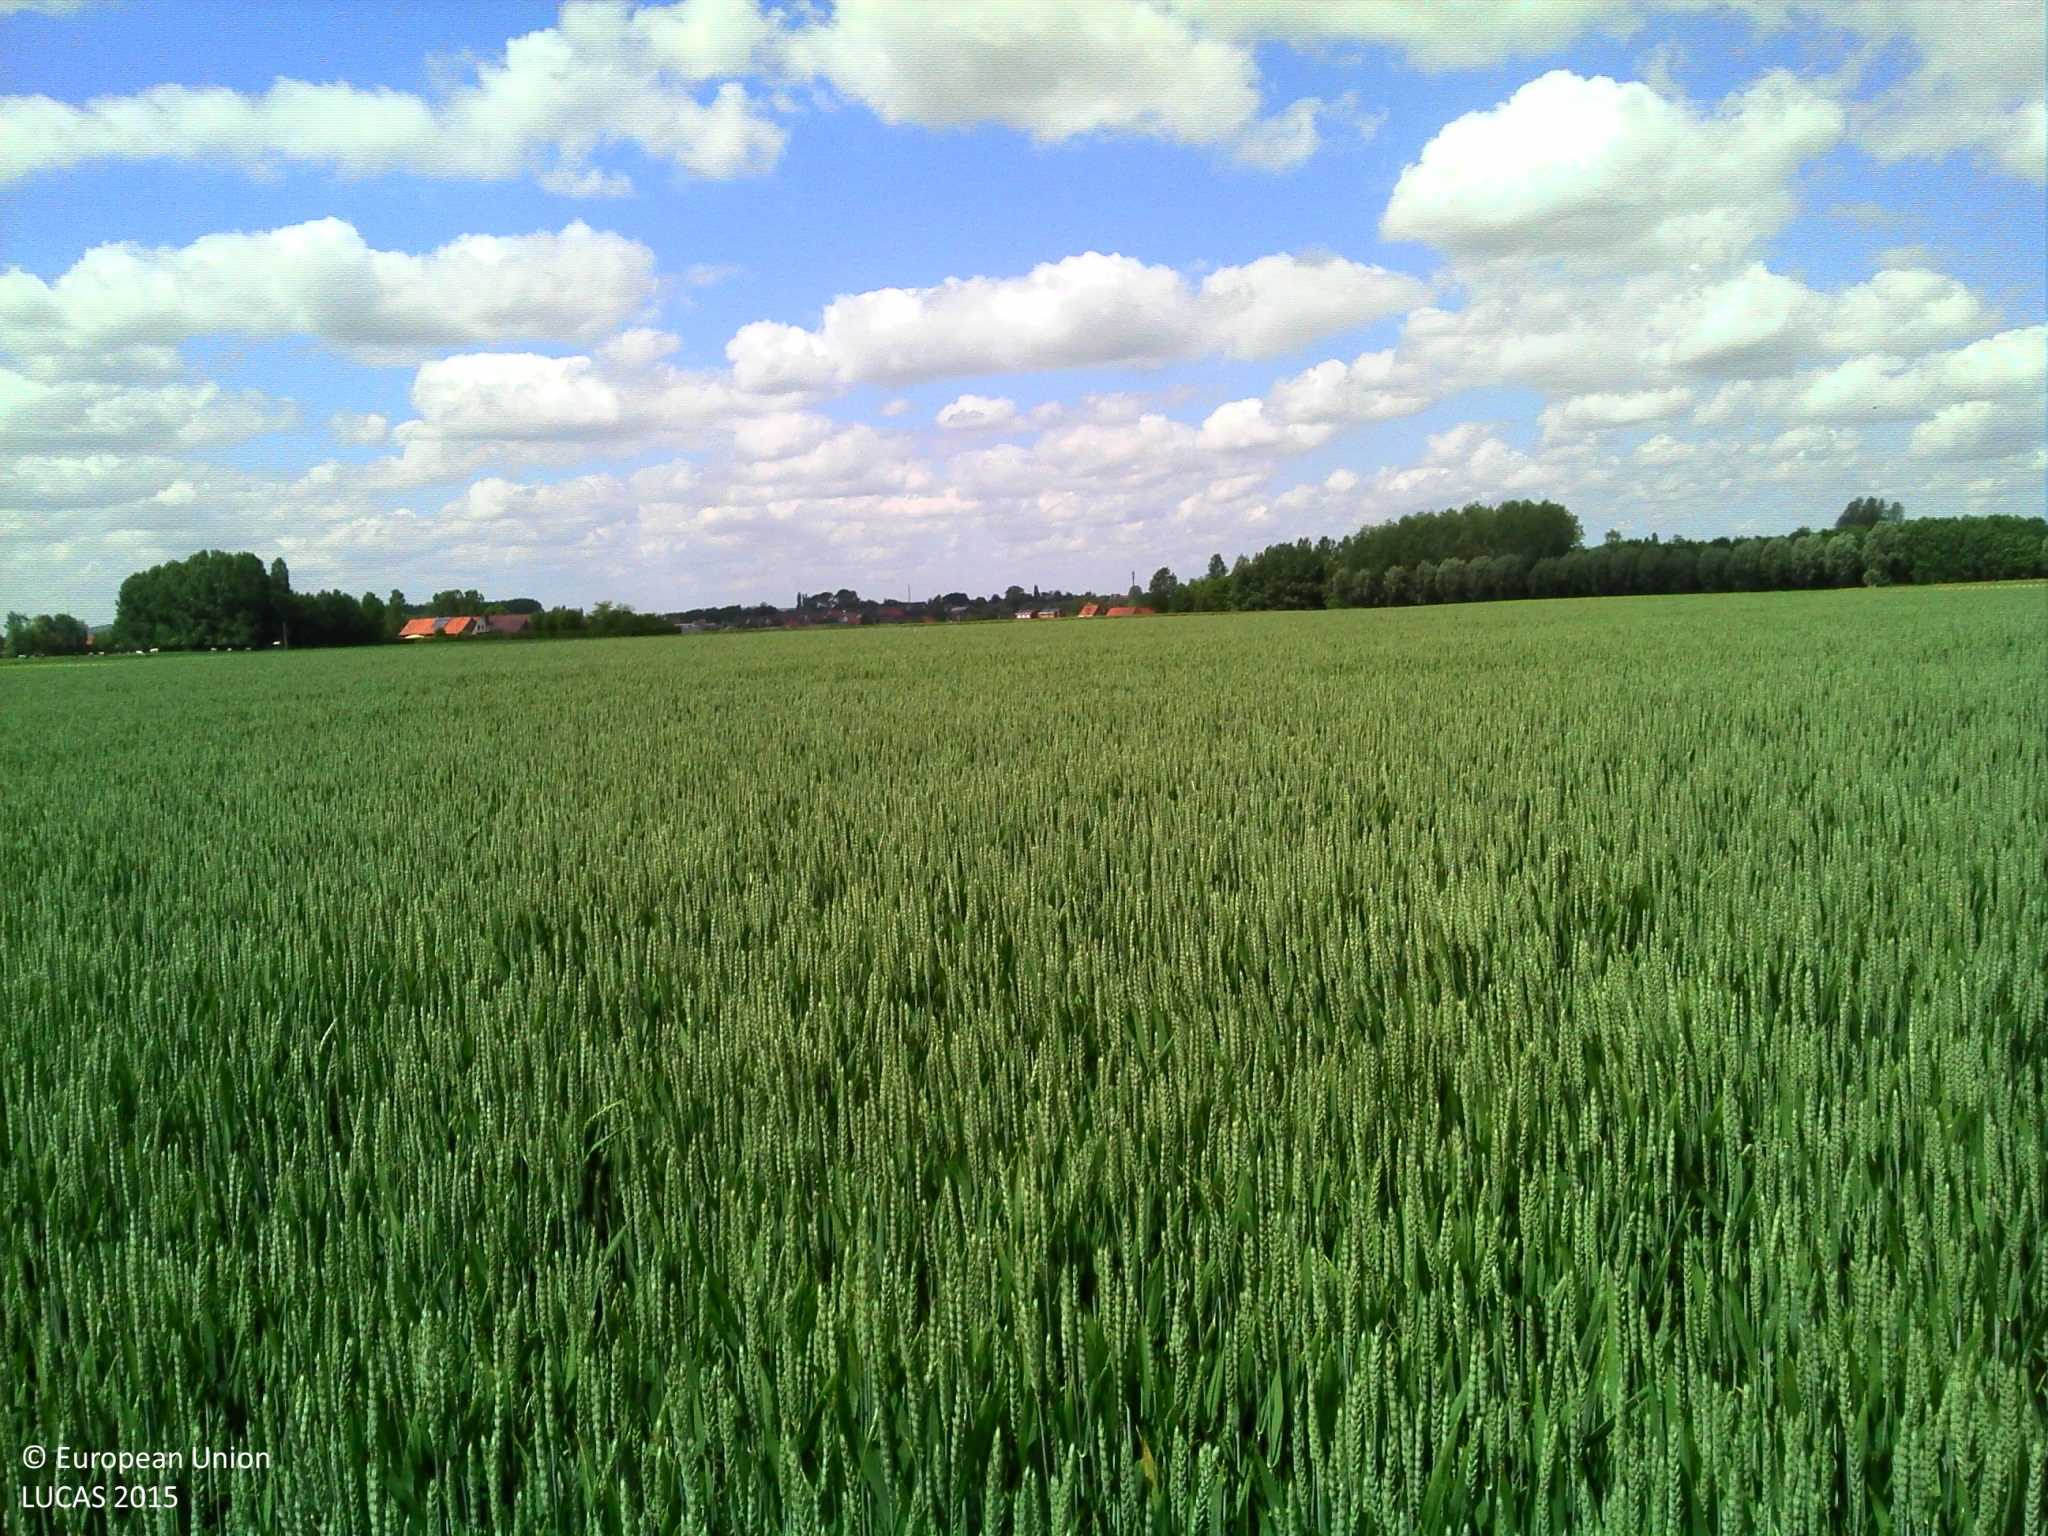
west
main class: Cropland
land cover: Common wheat
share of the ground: > 75 %
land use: Agriculture (excluding fallow land and kitchen gardens)
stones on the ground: < 10 %
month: June
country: BE
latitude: 50.8225
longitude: 2.7917
